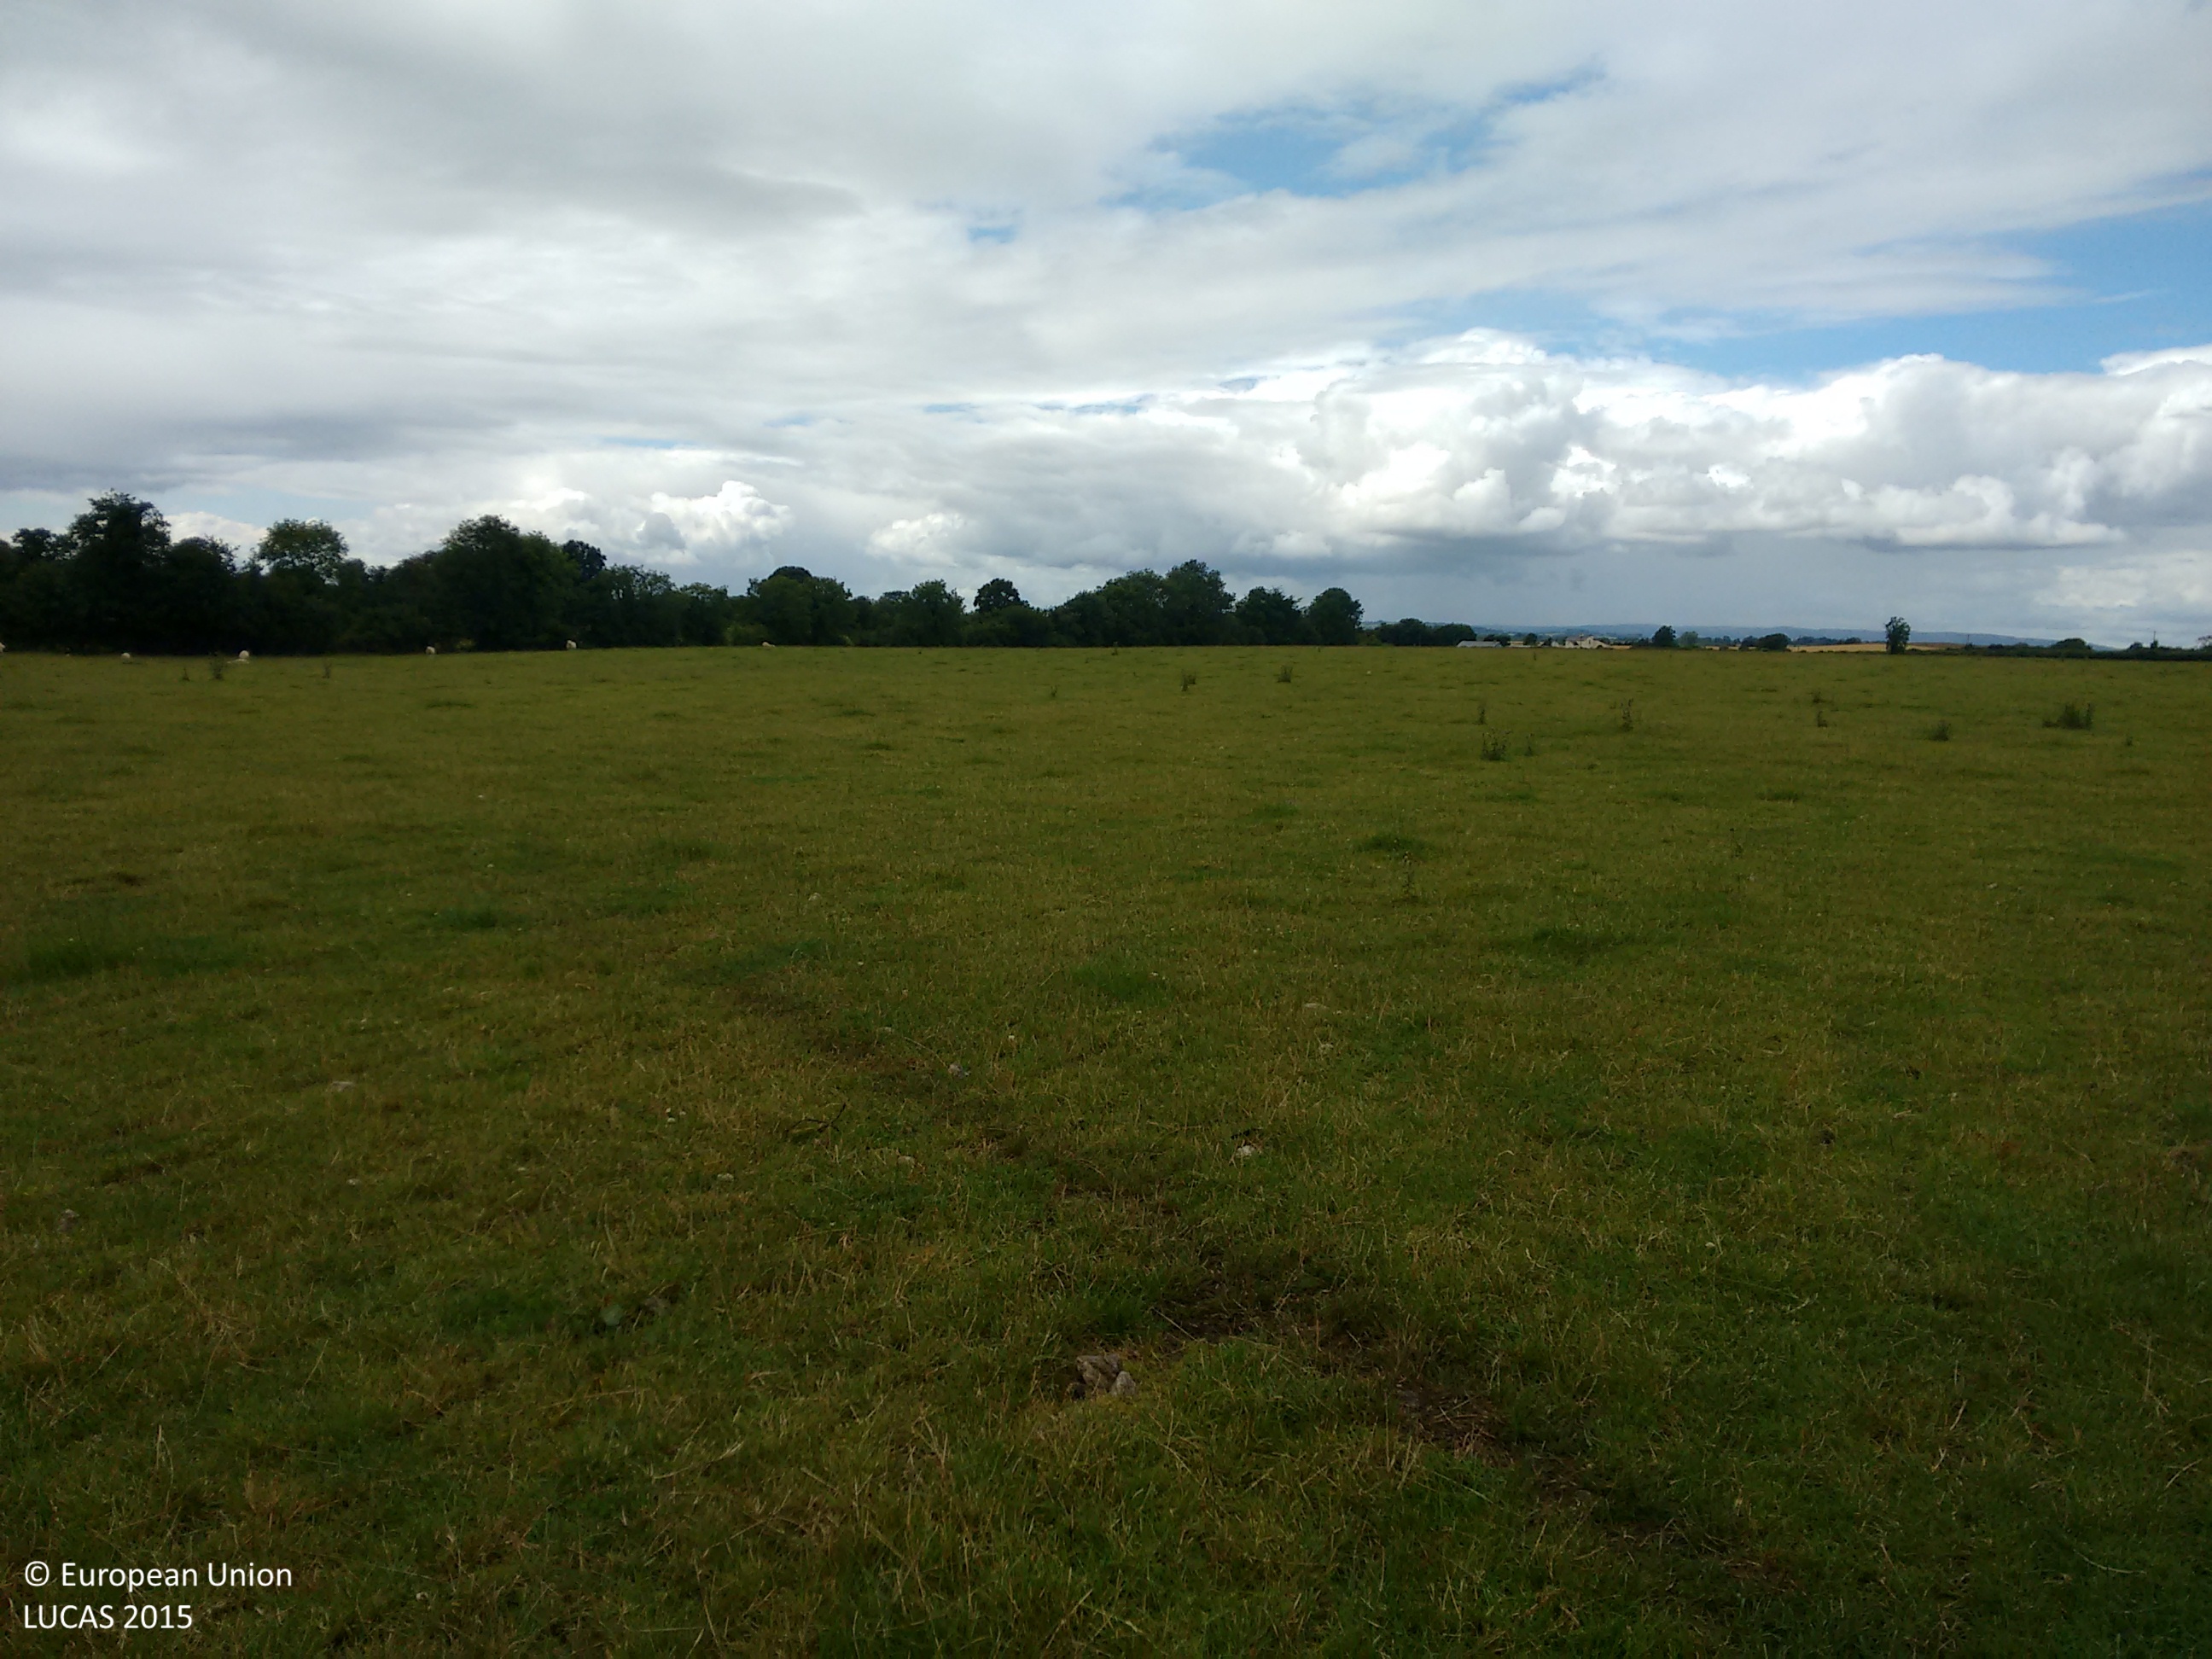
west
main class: Grassland
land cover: Grassland without tree/shrub cover
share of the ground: > 75 %
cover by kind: herbaceous plants 95 %, unconsolidated bare surface 5 %
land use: Agriculture (excluding fallow land and kitchen gardens)
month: July
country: IE
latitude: 52.7609
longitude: -6.7162
